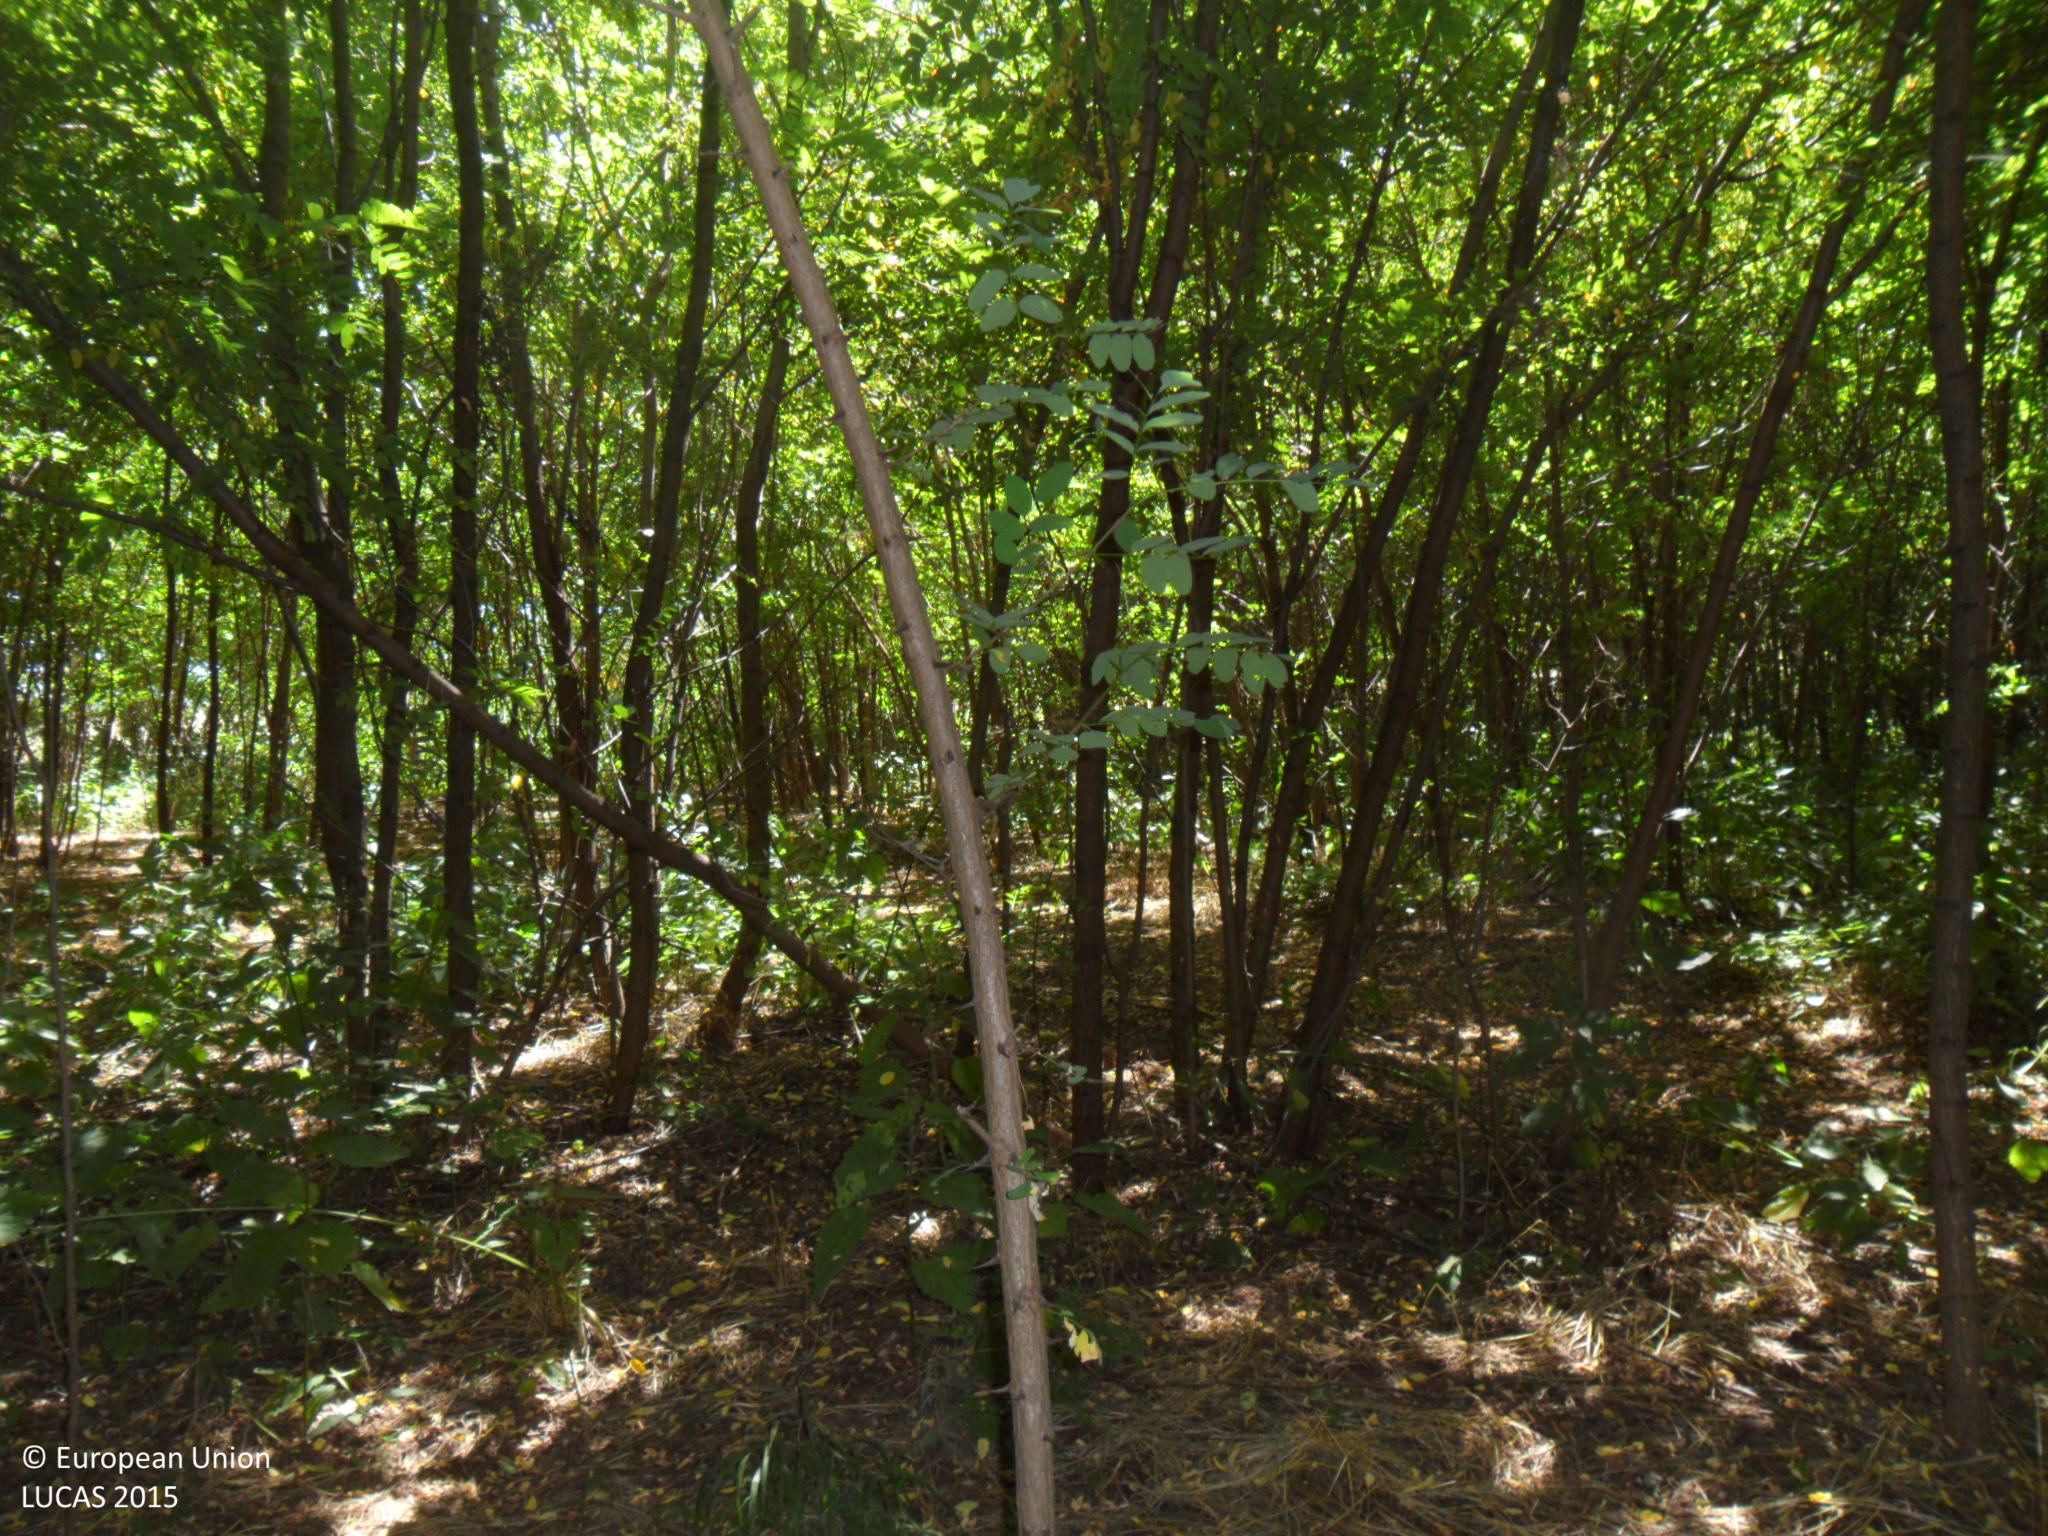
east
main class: Woodland
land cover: Broadleaved woodland
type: mesophytic deciduous forest
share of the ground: > 75 %
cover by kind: broadleaved forest trees 100 %
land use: Forestry
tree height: > 5 m
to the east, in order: Broadleaved woodland; Tracks; Broadleaved woodland; Grass margins; Tracks; Grass margins; Common wheat
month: July
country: BG
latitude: 43.8279
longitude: 26.3829
